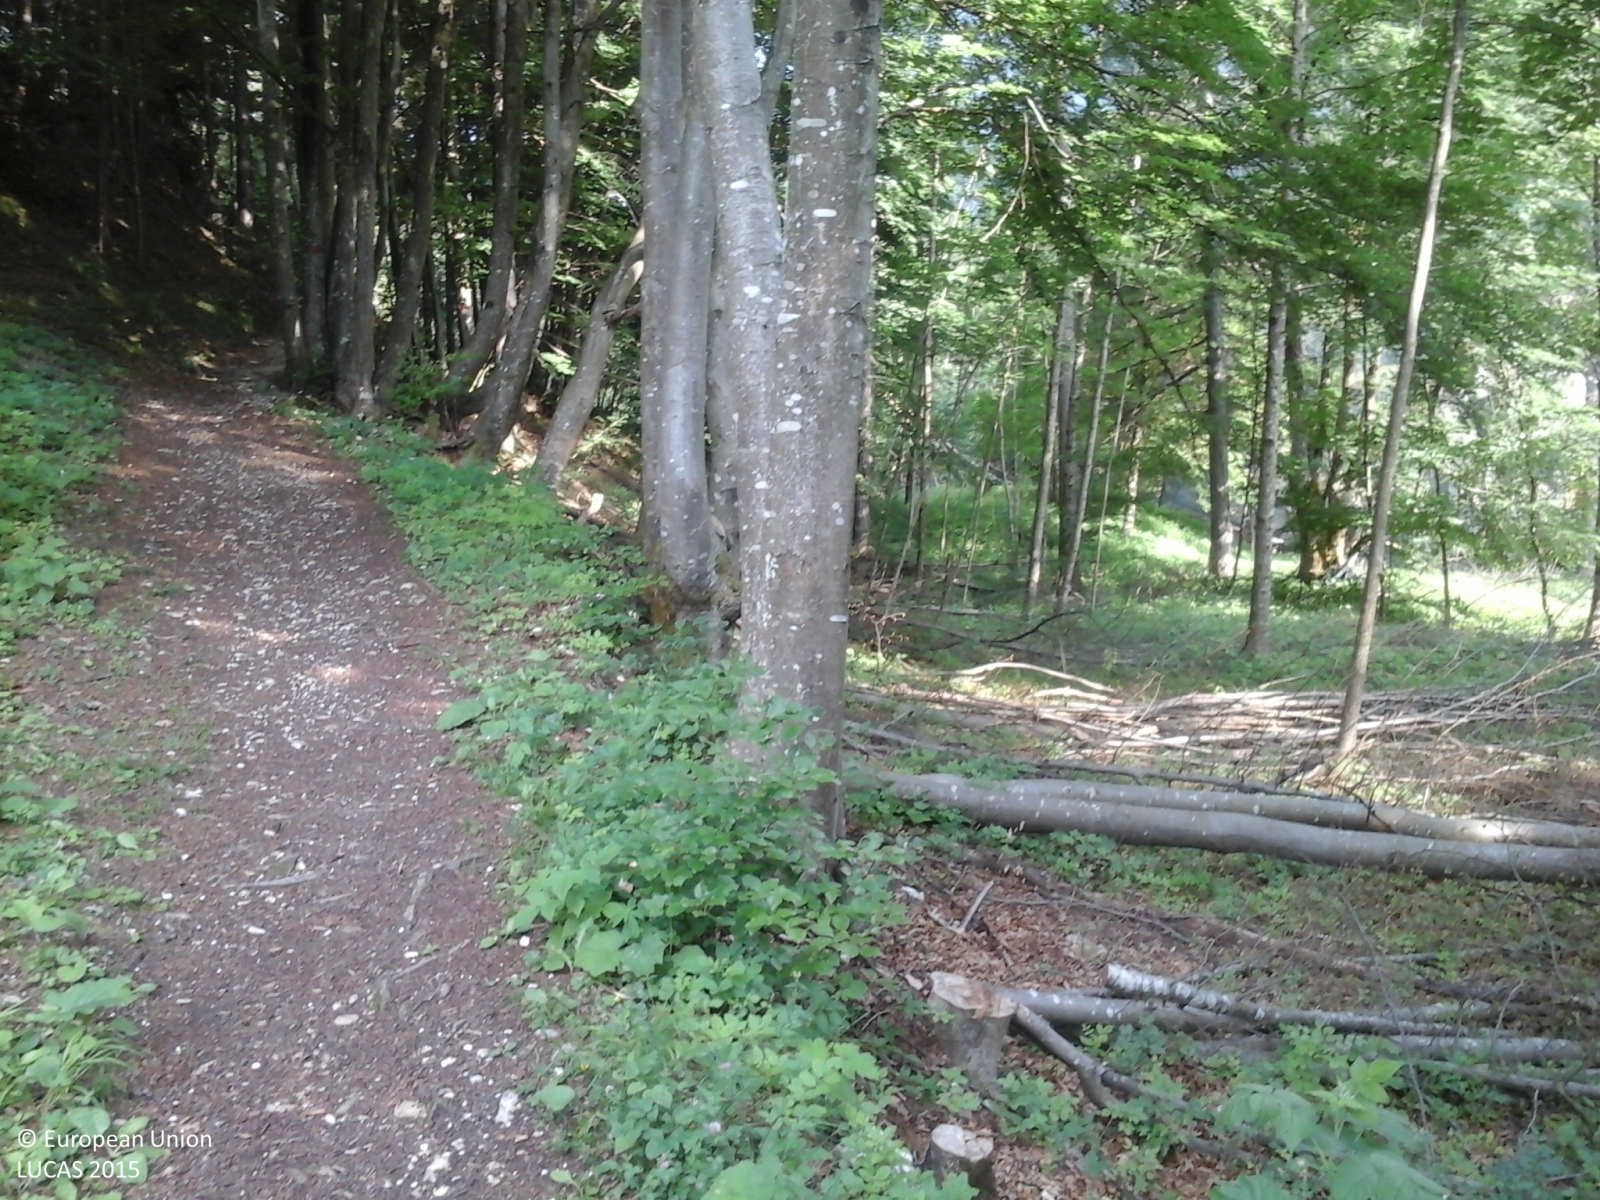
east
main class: Grassland
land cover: Grassland without tree/shrub cover
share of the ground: > 75 %
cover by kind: herbaceous plants 100 %
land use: Agriculture (excluding fallow land and kitchen gardens)
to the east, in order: Tracks; Other mixed woodland; Electric lines; Other mixed woodland; Tracks; Other mixed woodland; Ditches and canals; Other mixed woodland
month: June
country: IT
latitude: 46.3468
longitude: 12.1934
